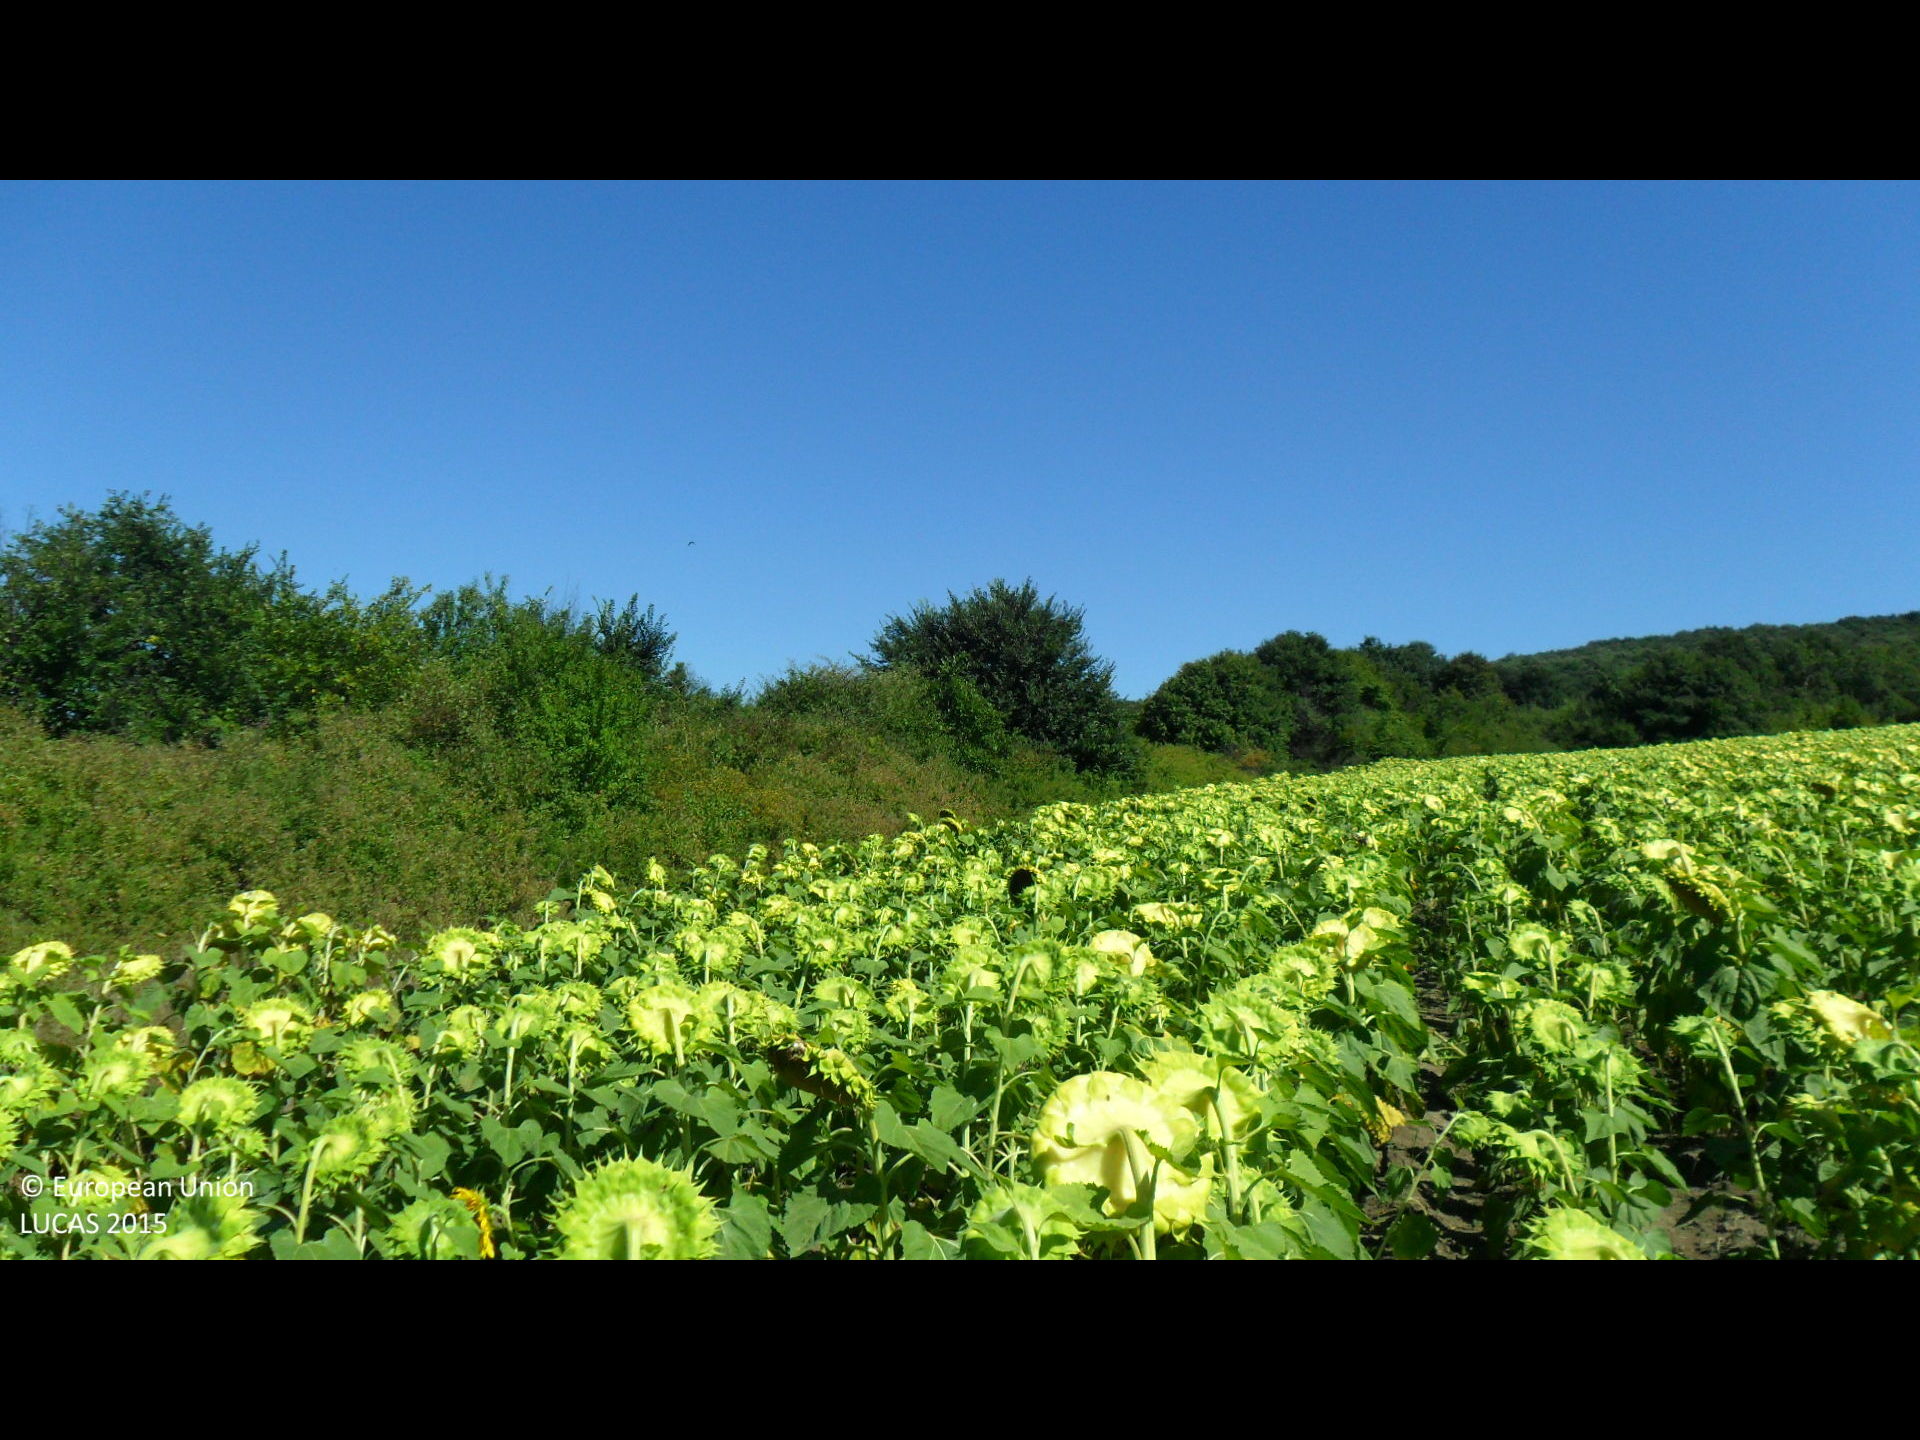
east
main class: Cropland
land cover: Sunflower
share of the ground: > 75 %
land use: Agriculture (excluding fallow land and kitchen gardens)
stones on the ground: < 10 %
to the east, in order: Sunflower; Shrubland with sparse tree cover; Grassland without tree/shrub cover
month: September
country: BG
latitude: 43.1214
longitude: 26.4332
